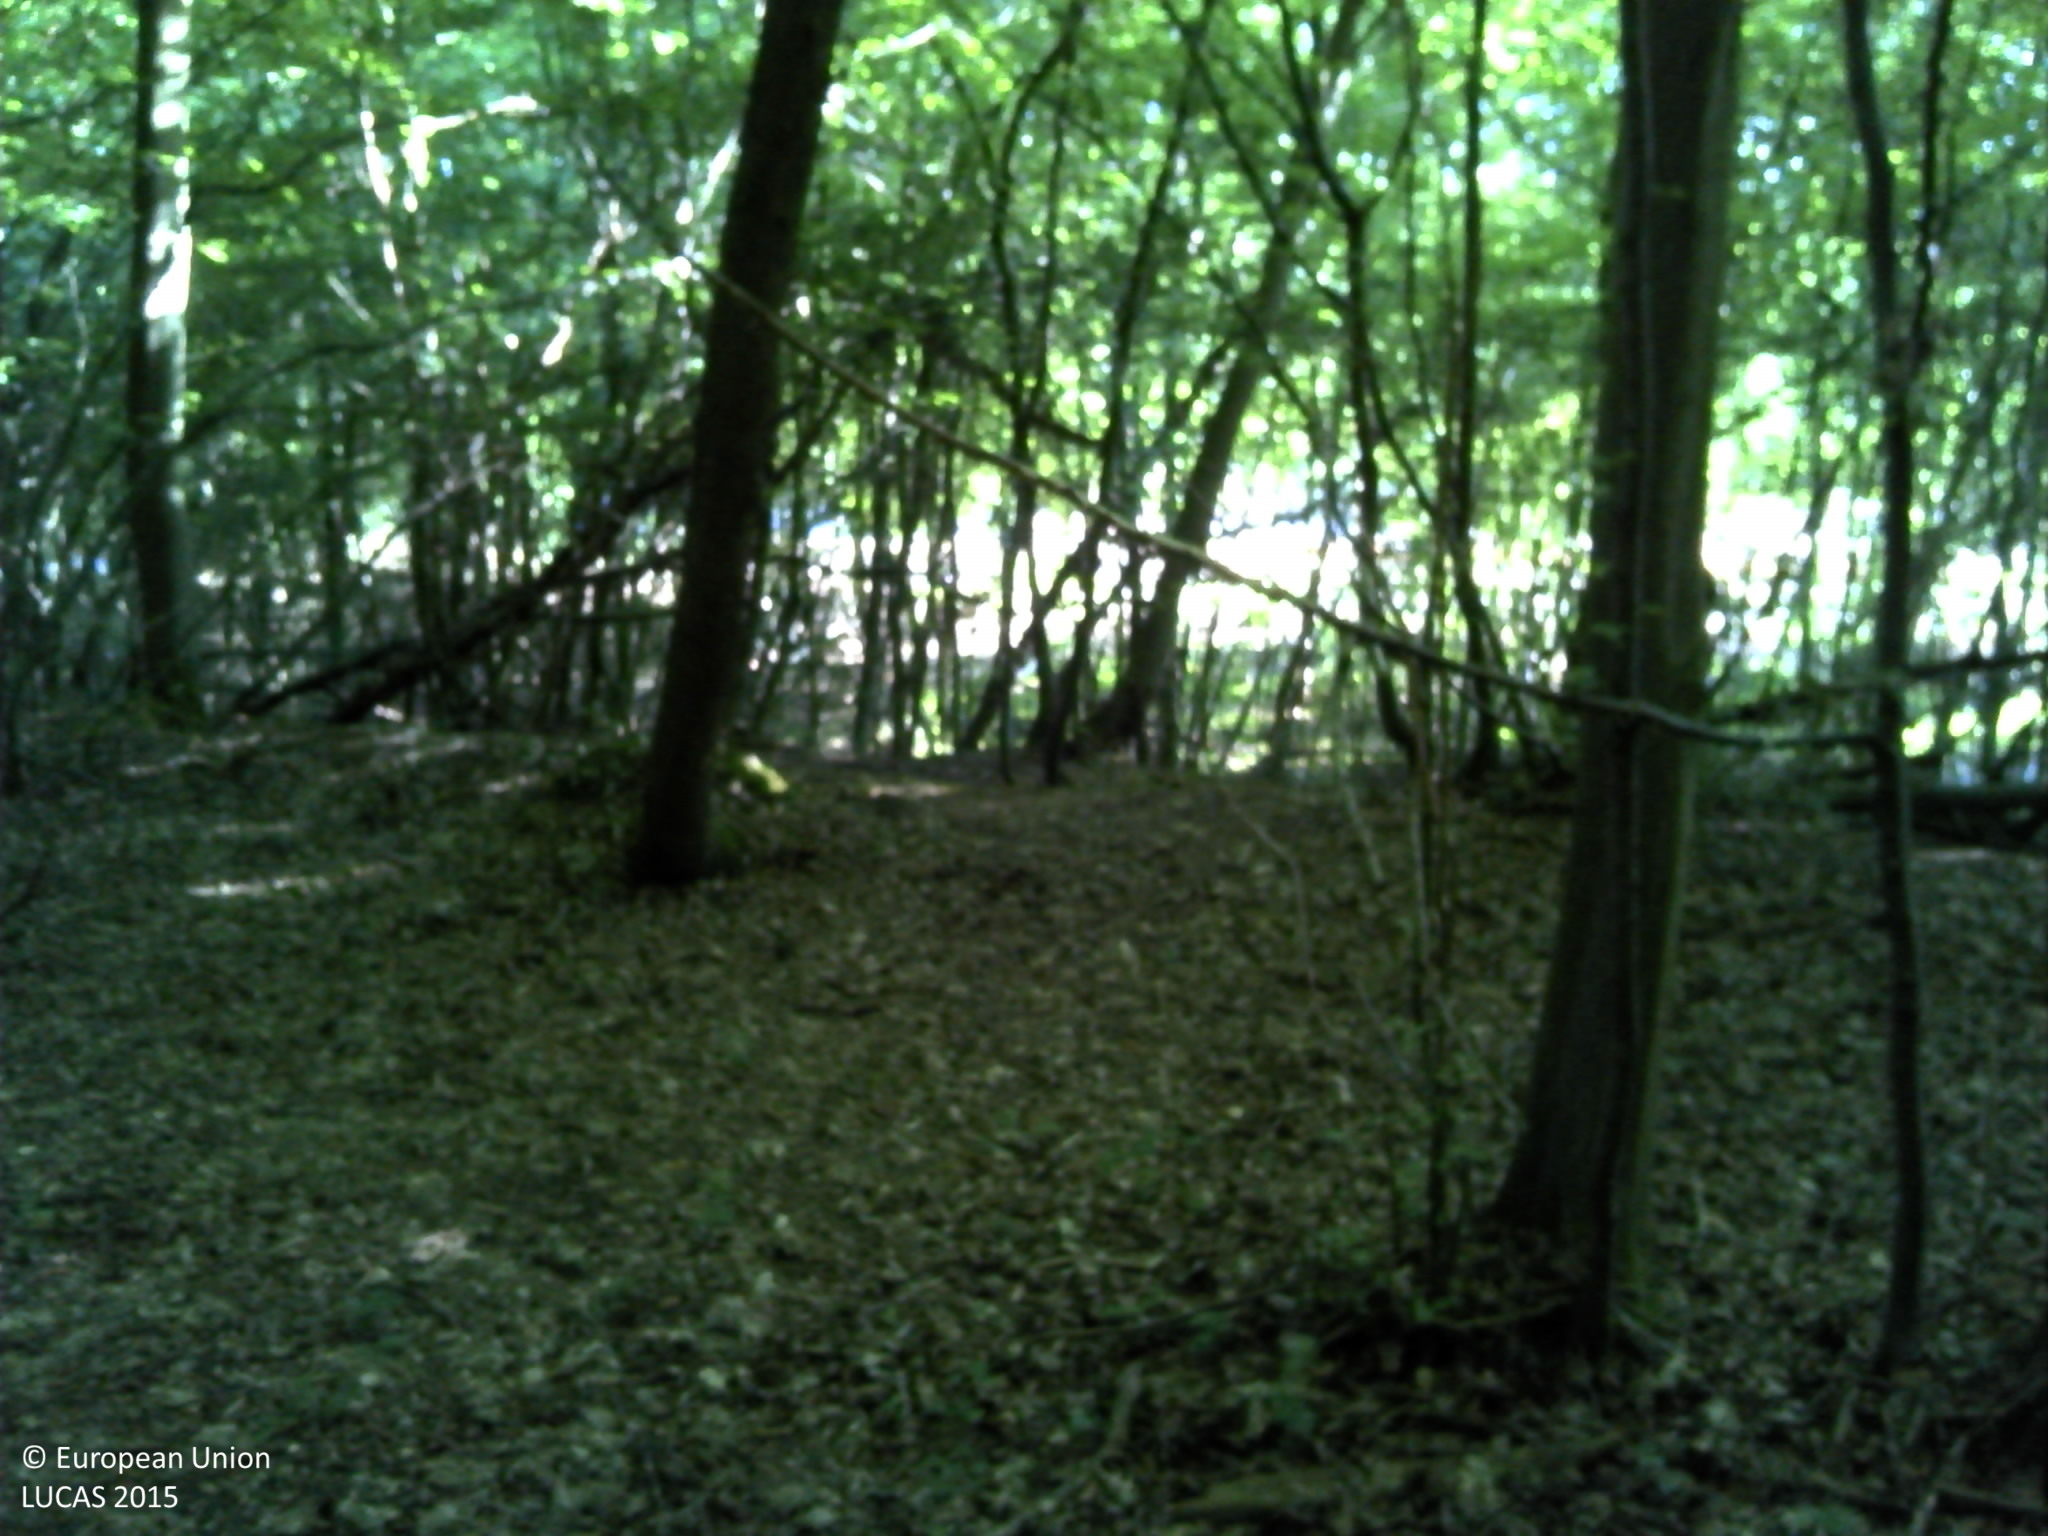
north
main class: Woodland
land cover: Broadleaved woodland
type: mesophytic deciduous forest
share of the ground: > 75 %
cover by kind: broadleaved forest trees 100 %
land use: Forestry
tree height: > 5 m
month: June
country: FR
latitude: 49.2692
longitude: 1.0314
